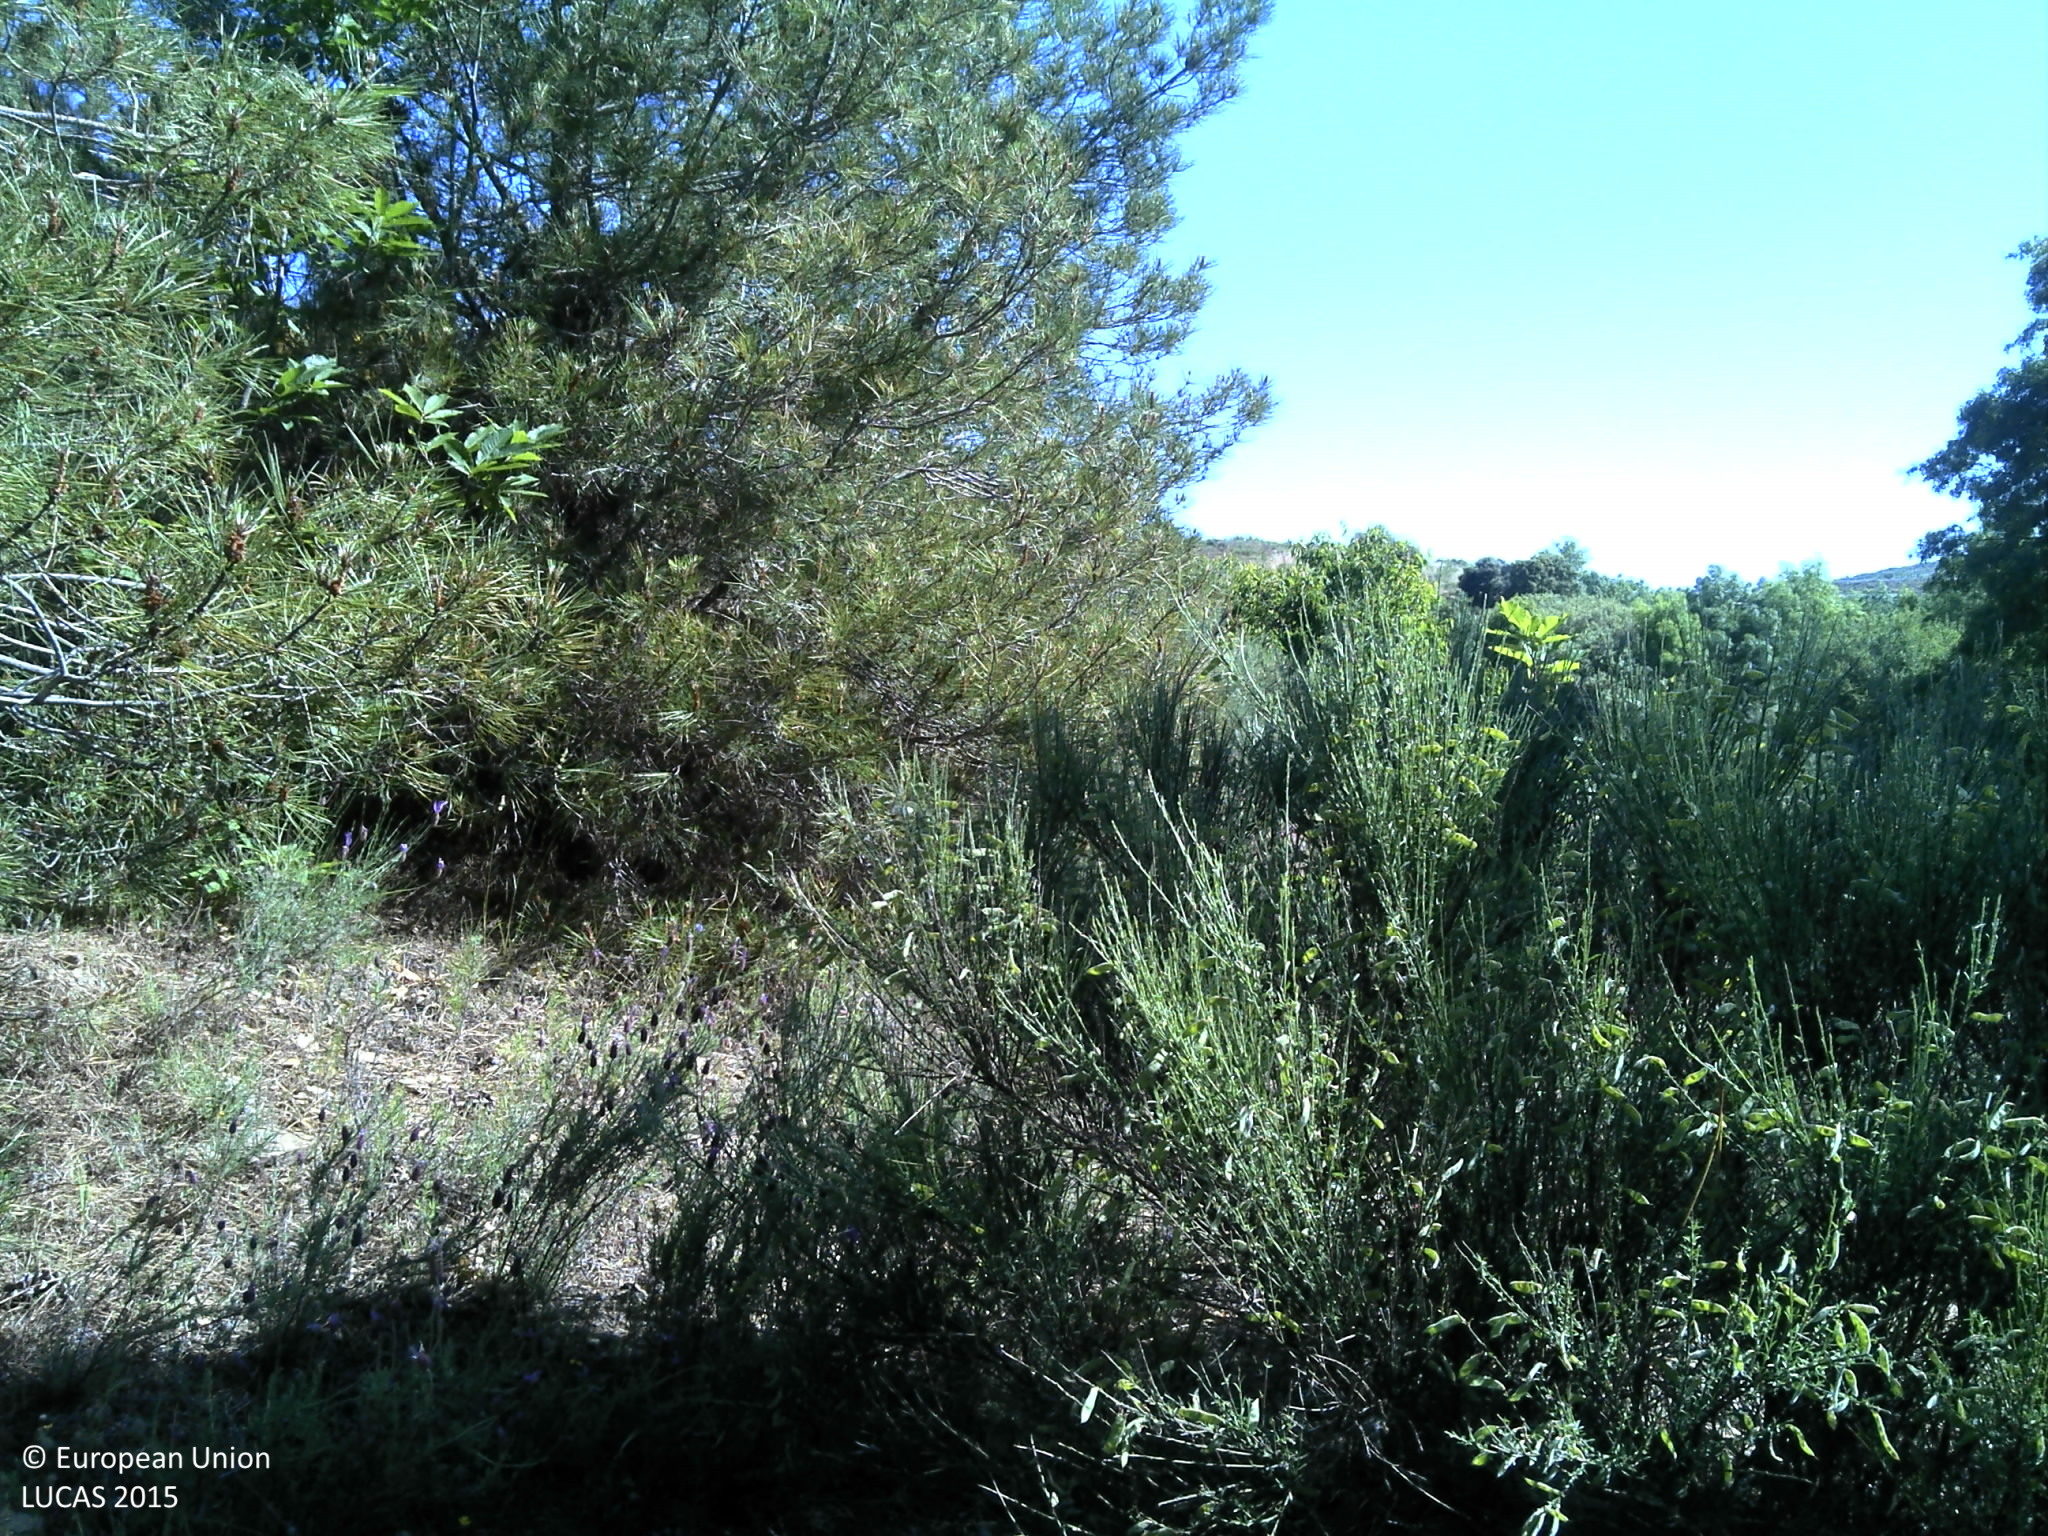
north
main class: Woodland
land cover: Pine dominated coniferous woodland
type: coniferous forest of the mediterranean region
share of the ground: 10 - 25 %
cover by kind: coniferous forest trees 20 %, shrubs 20 %, herbaceous plants 10 %, unconsolidated bare surface 10 %
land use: Forestry
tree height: > 5 m
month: May
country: PT
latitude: 41.5585
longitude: -6.5432
